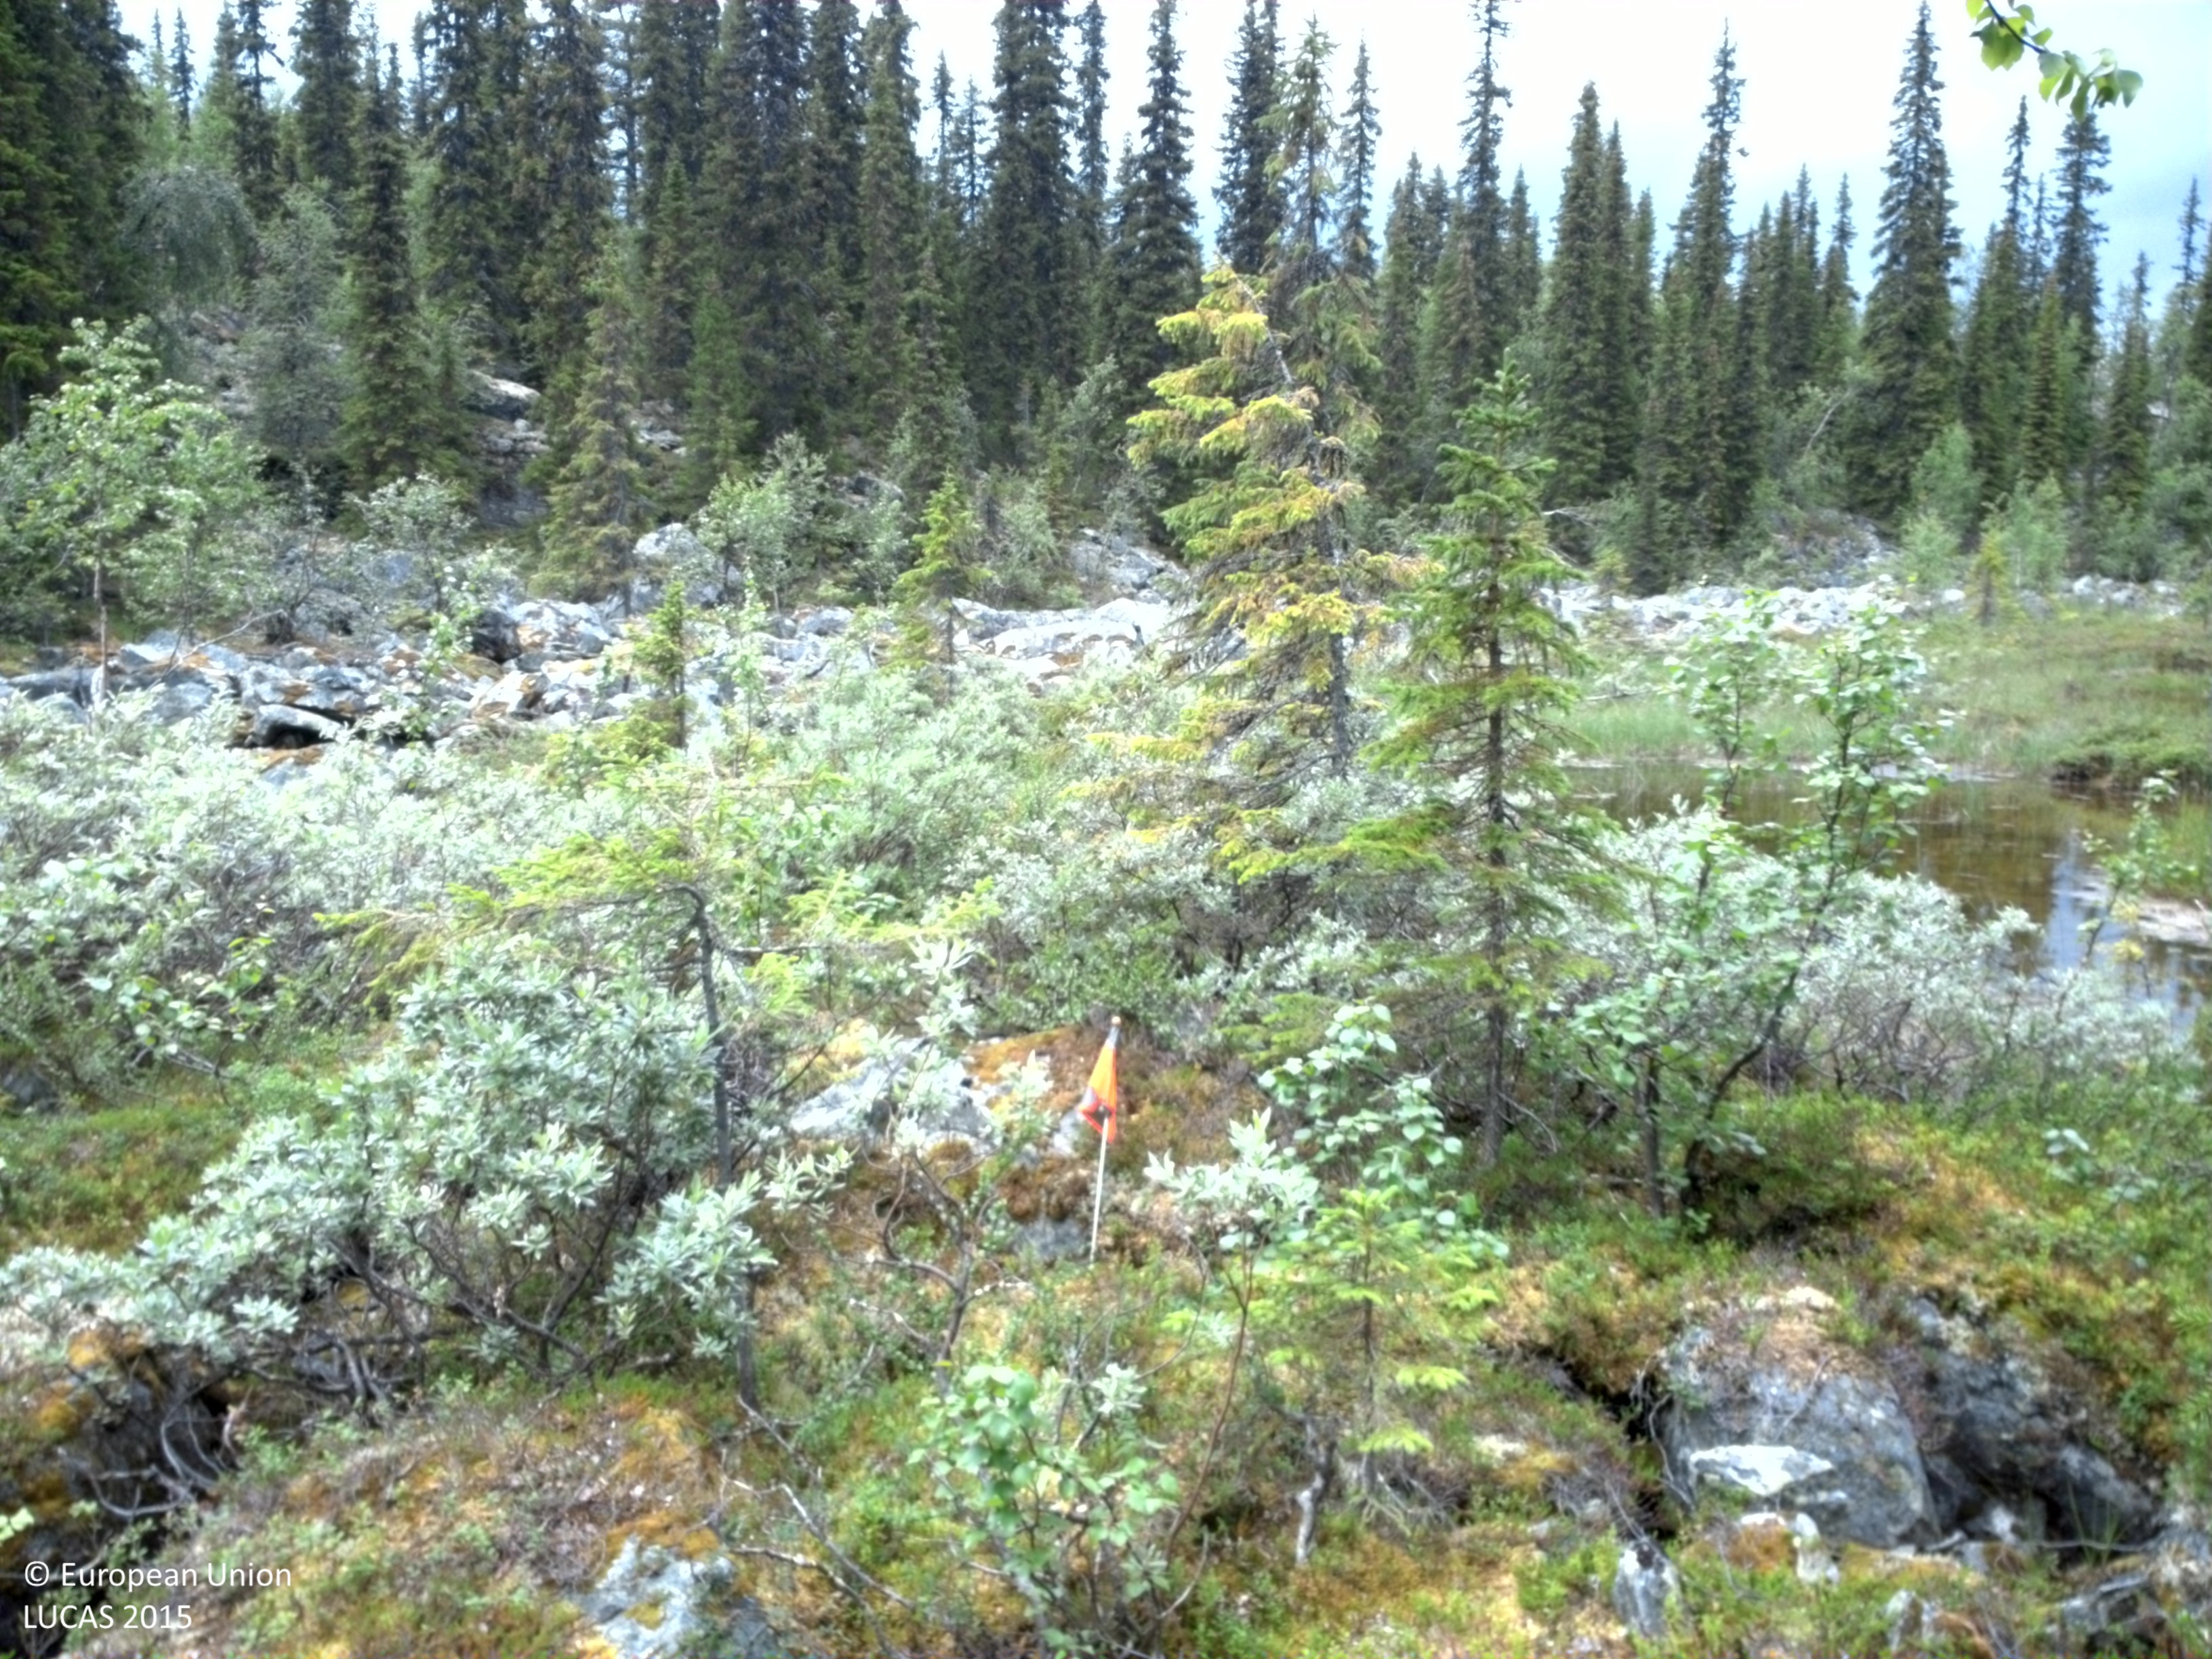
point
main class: Shrubland
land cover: Shrubland with sparse tree cover
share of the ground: 50 - 75 %
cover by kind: shrubs 60 %, lichens and mosses 20 %, consolidated bare surface 15 %, coniferous forest trees 5 %
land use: Amenities, museums, leisure
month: August
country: SE
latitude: 65.0031
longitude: 15.6721
